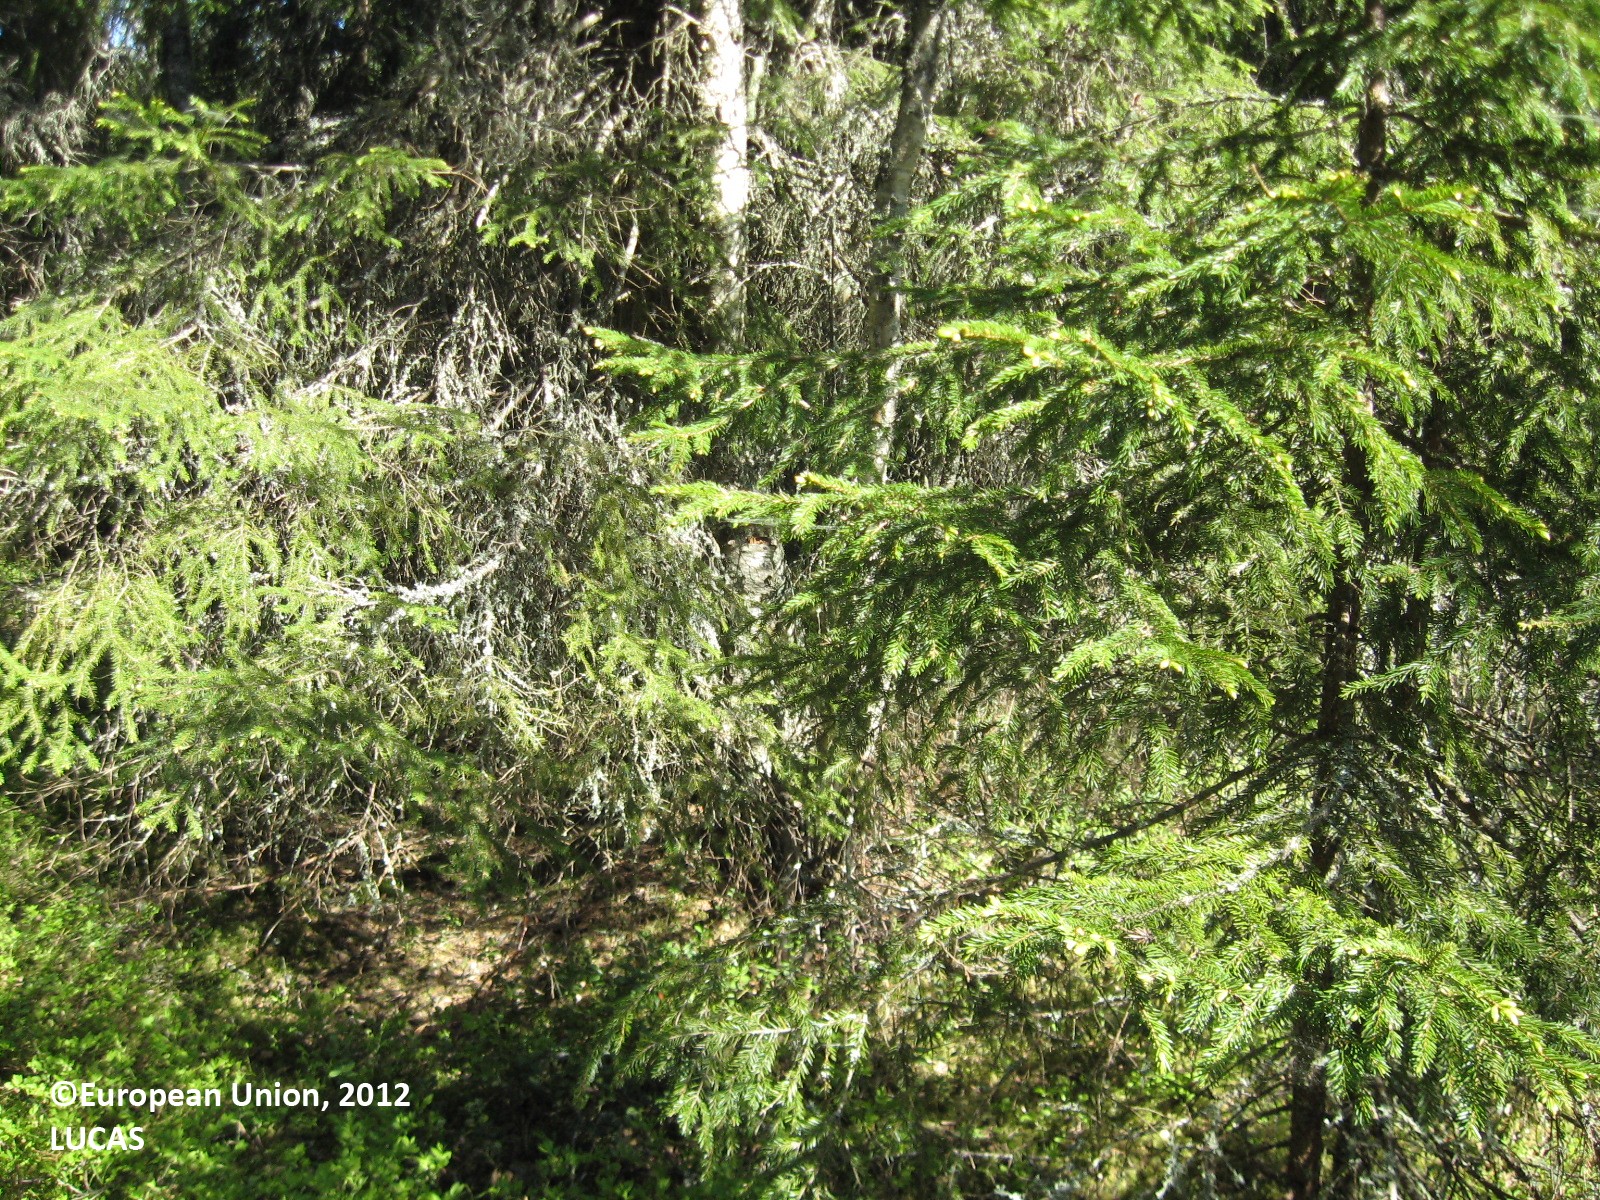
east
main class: Woodland
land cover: Spruce dominated coniferous woodland
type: boreal forest
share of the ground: > 75 %
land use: Forestry
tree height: > 5 m
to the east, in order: Spruce dominated coniferous woodland; Ditches and canals; Spruce dominated mixed woodland; Spruce dominated coniferous woodland; Shrubland without tree cover
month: June
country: FI
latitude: 63.2546
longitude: 21.4093
